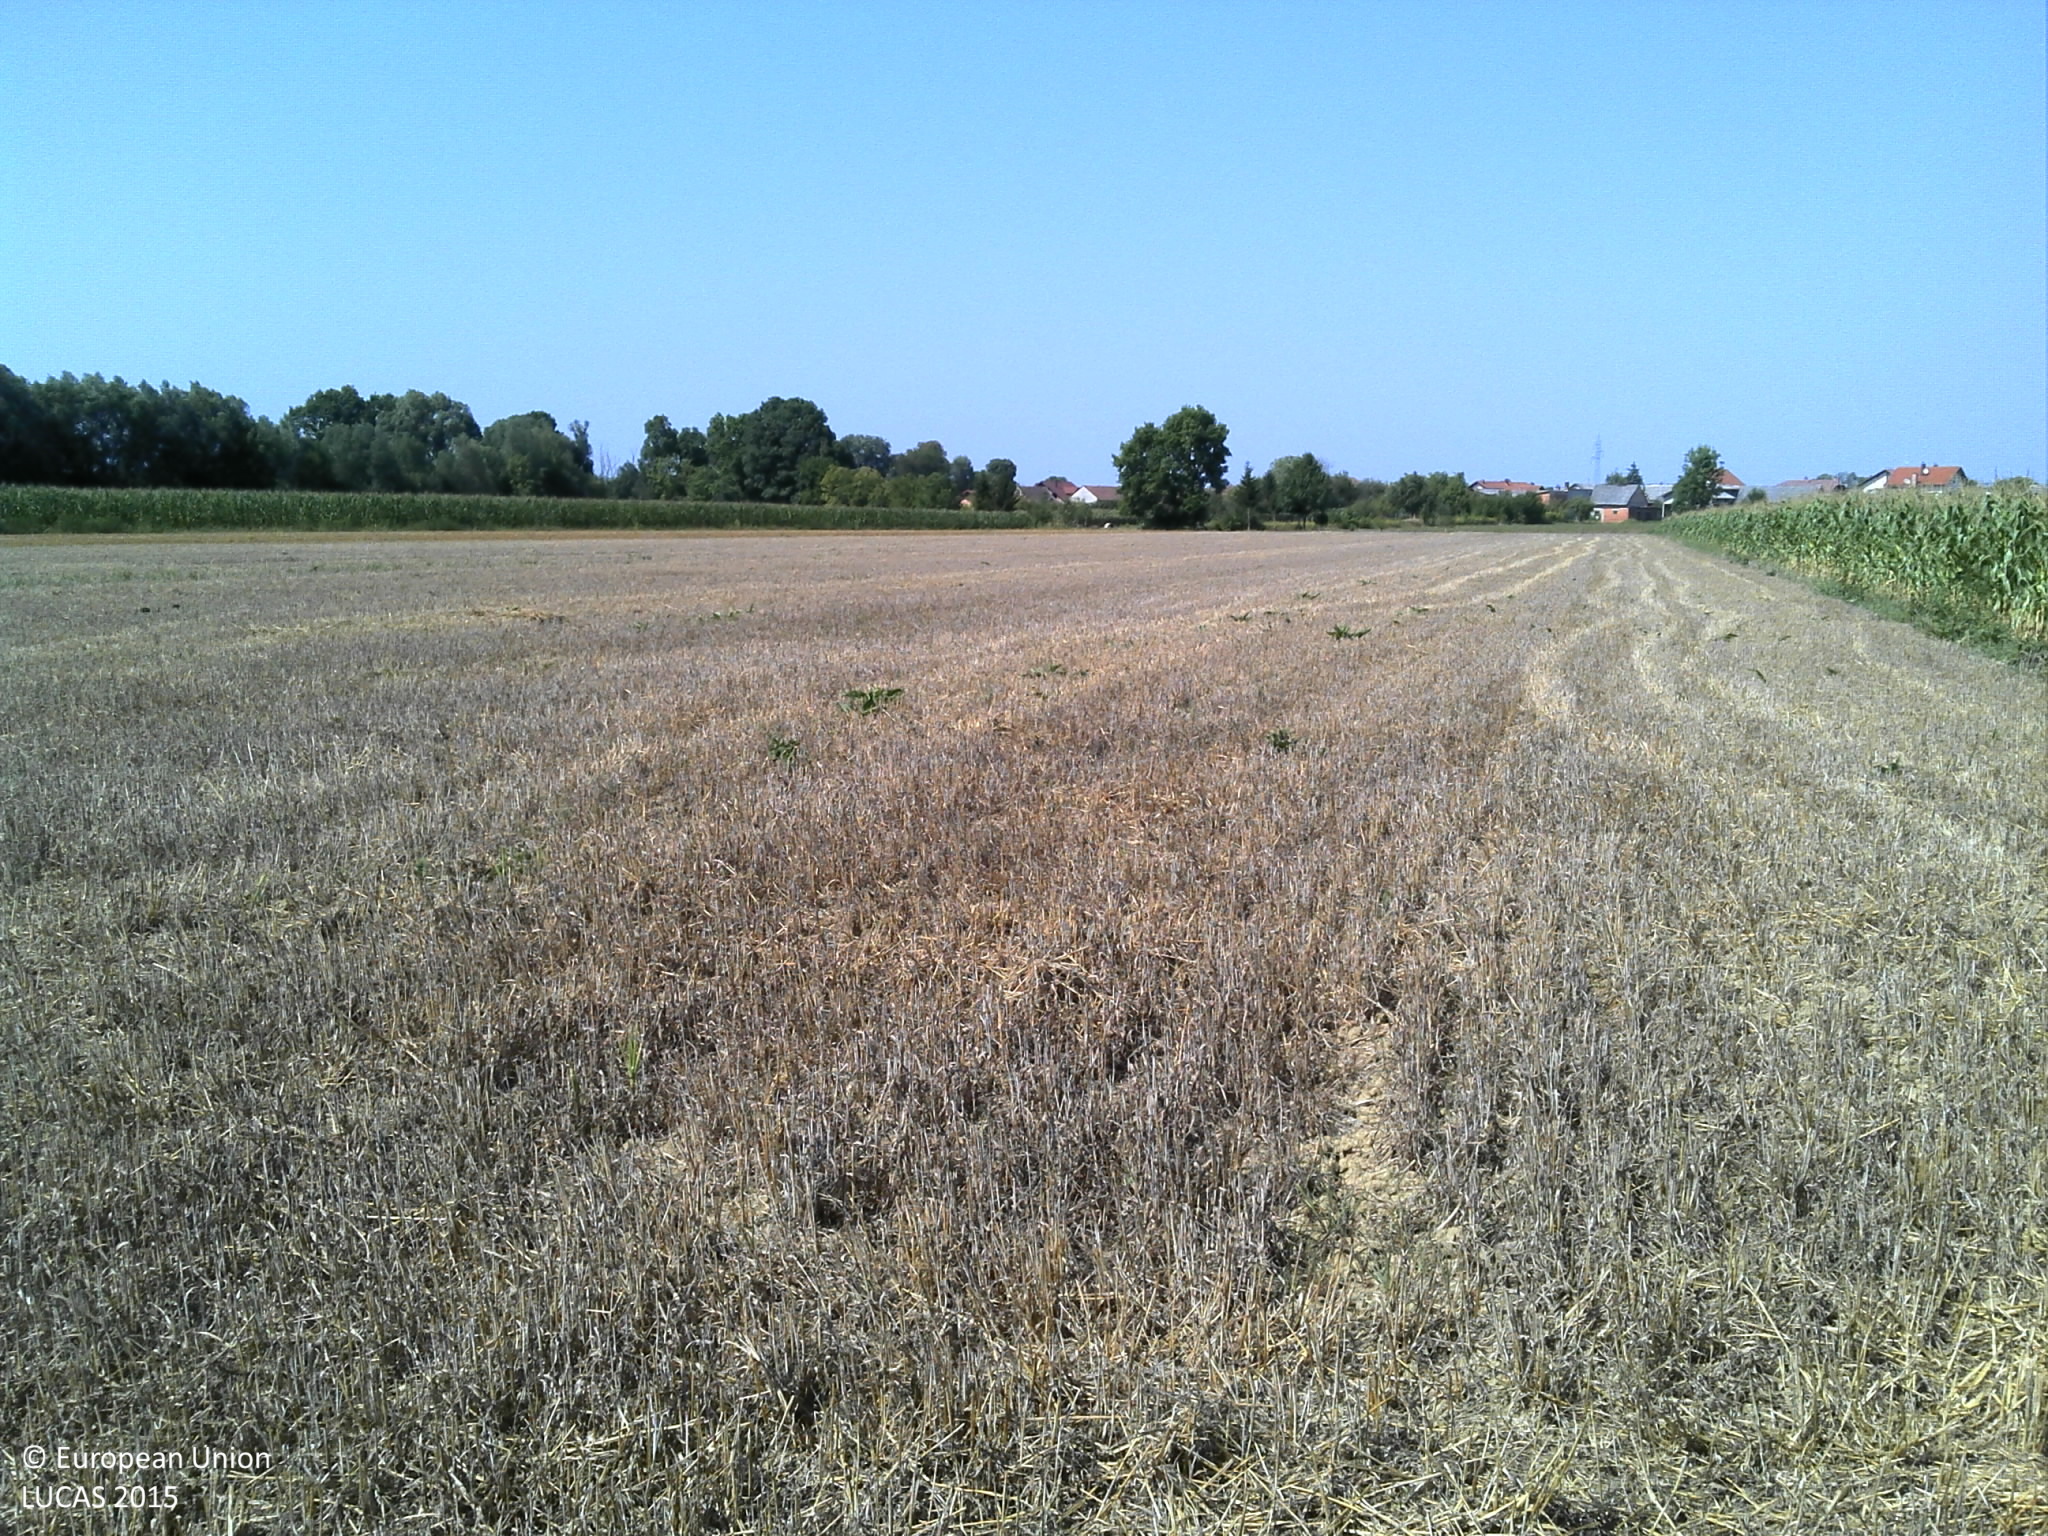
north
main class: Cropland
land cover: Barley
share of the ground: > 75 %
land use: Agriculture (excluding fallow land and kitchen gardens)
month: August
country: HR
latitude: 45.5160
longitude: 16.2831
